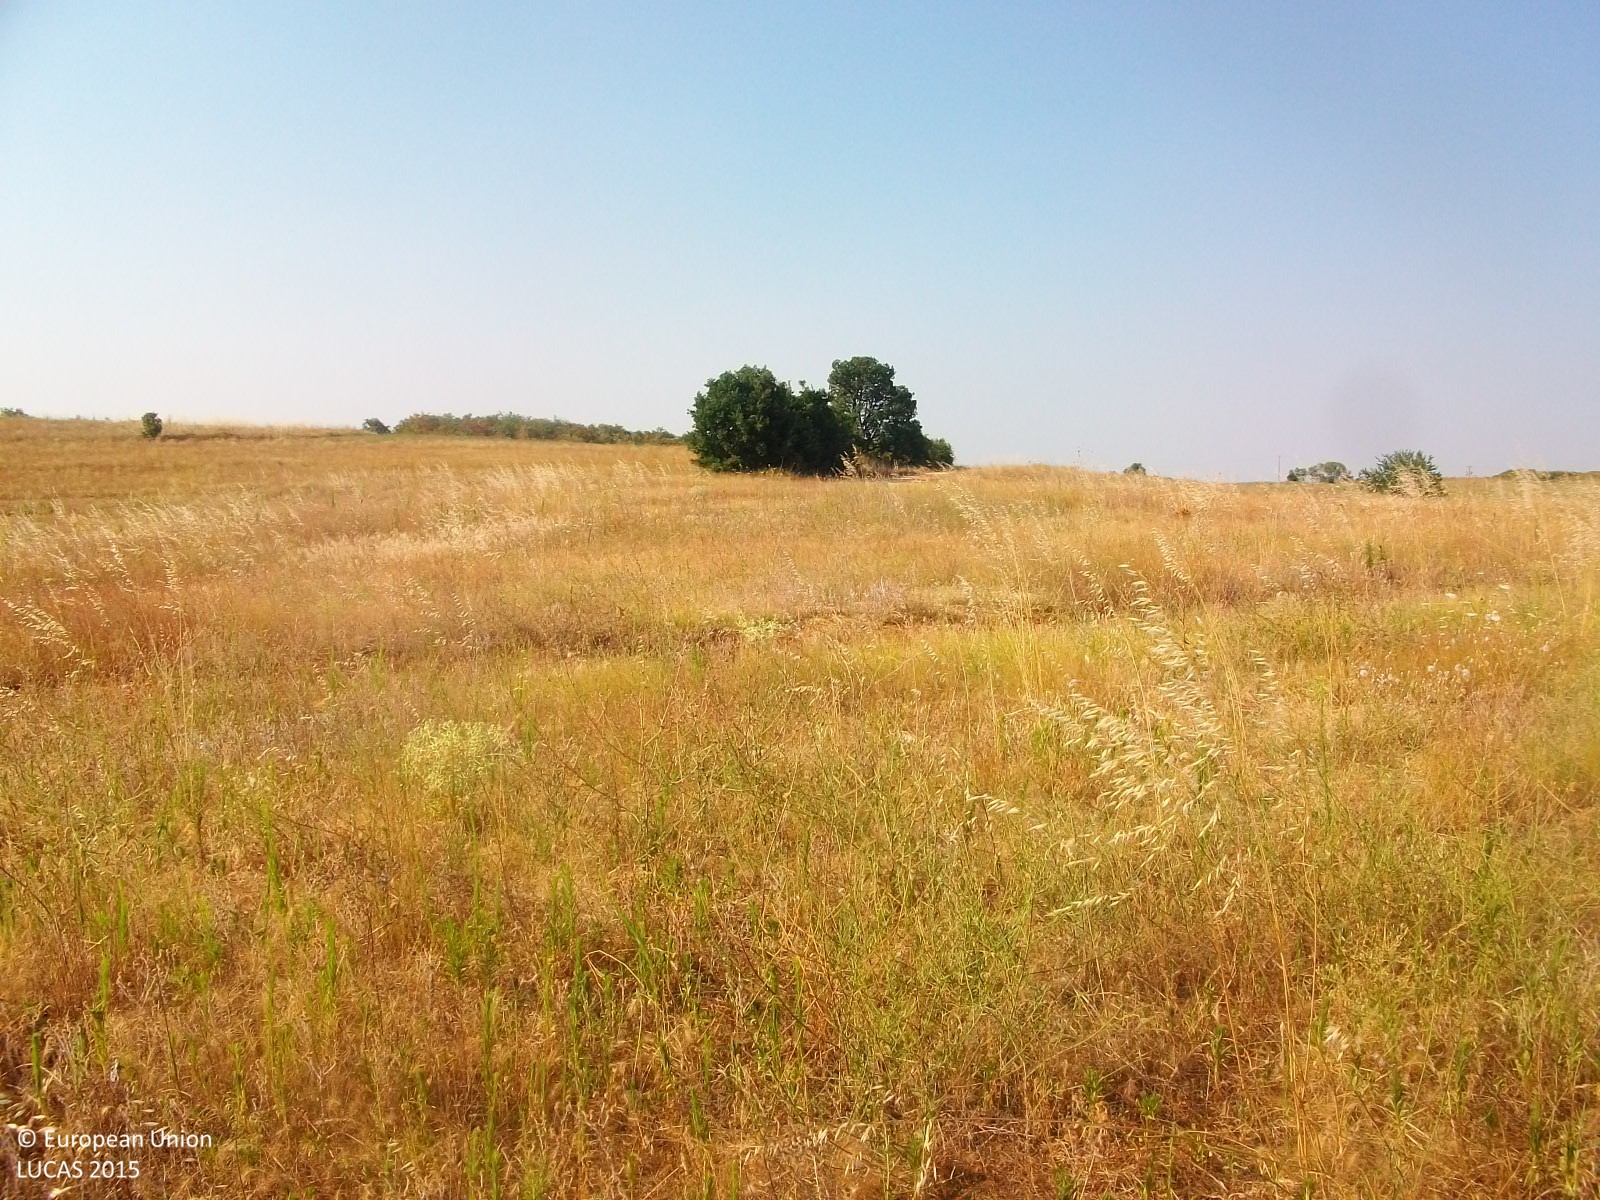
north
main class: Grassland
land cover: Spontaneously vegetated surfaces
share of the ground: > 75 %
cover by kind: herbaceous plants 100 %
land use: Fallow land
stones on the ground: 25 - 50 %
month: July
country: GR
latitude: 41.3297
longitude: 26.2608
